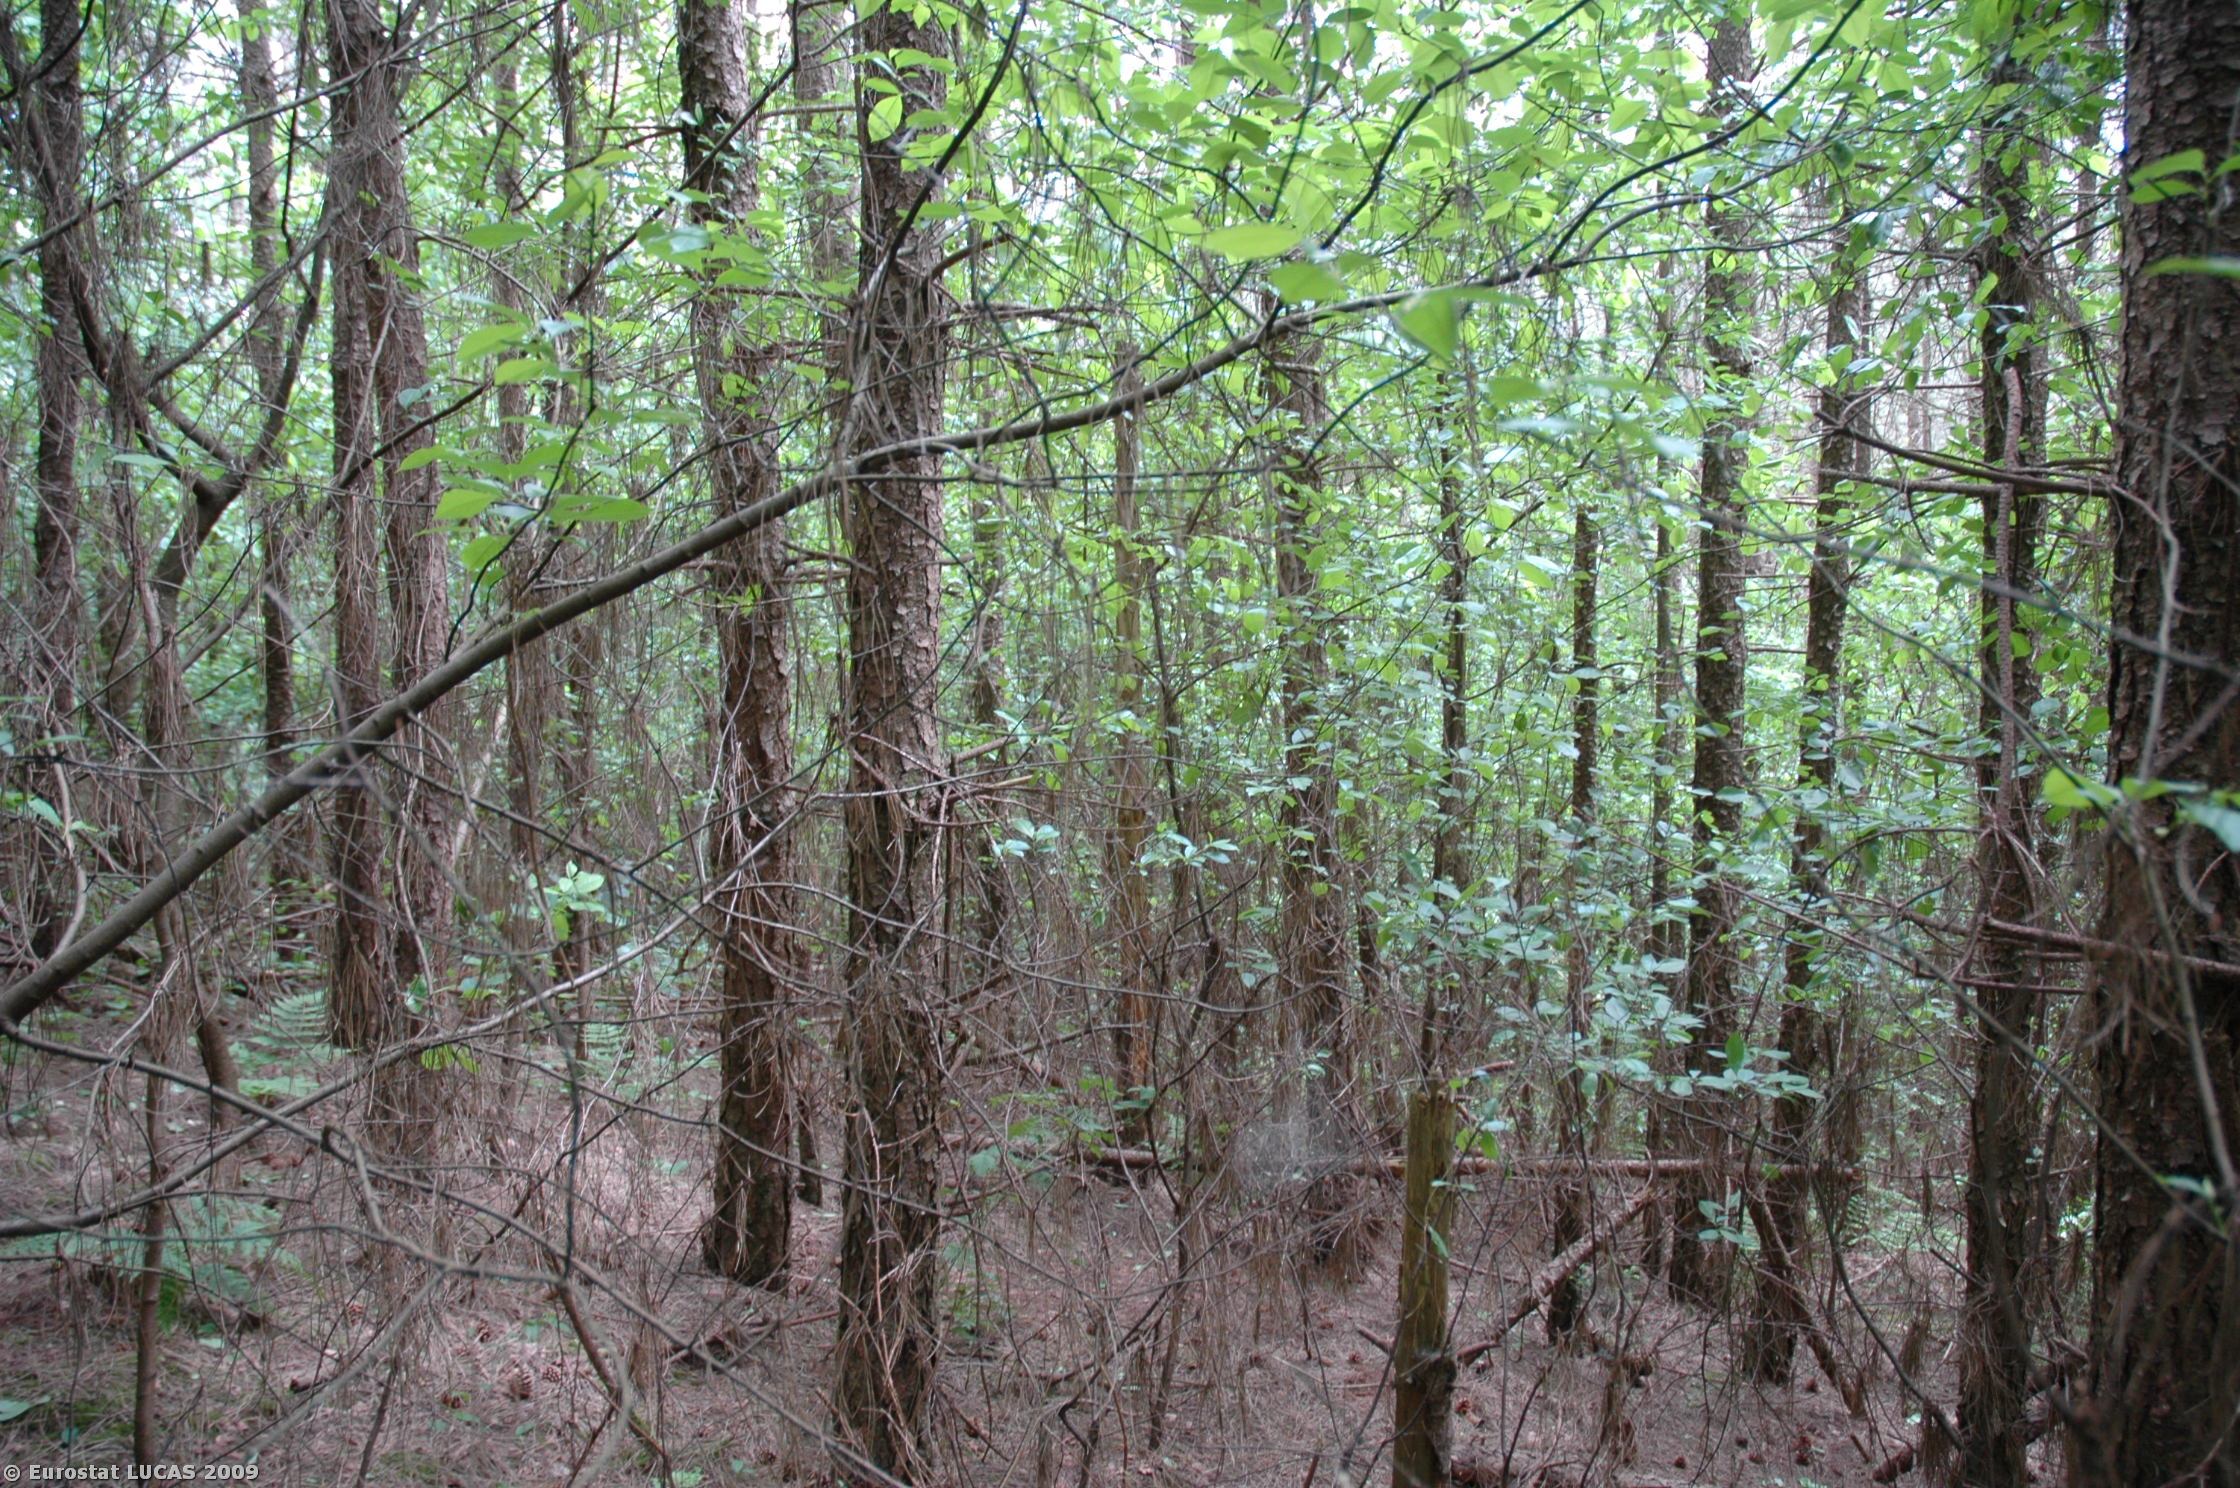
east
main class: Woodland
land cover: Mixed woodland
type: hemiboreal forest and nemoral coniferous forest and mixed broadleaved-coniferous forest
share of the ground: > 75 %
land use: Unused
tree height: > 5 m
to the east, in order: Mixed woodland; Grassland with sparse tree/shrub cover; Tracks; Grassland with sparse tree/shrub cover; Tracks; Mixed woodland; Tracks; Mixed woodland
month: May
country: NL
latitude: 52.0198
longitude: 5.4371
